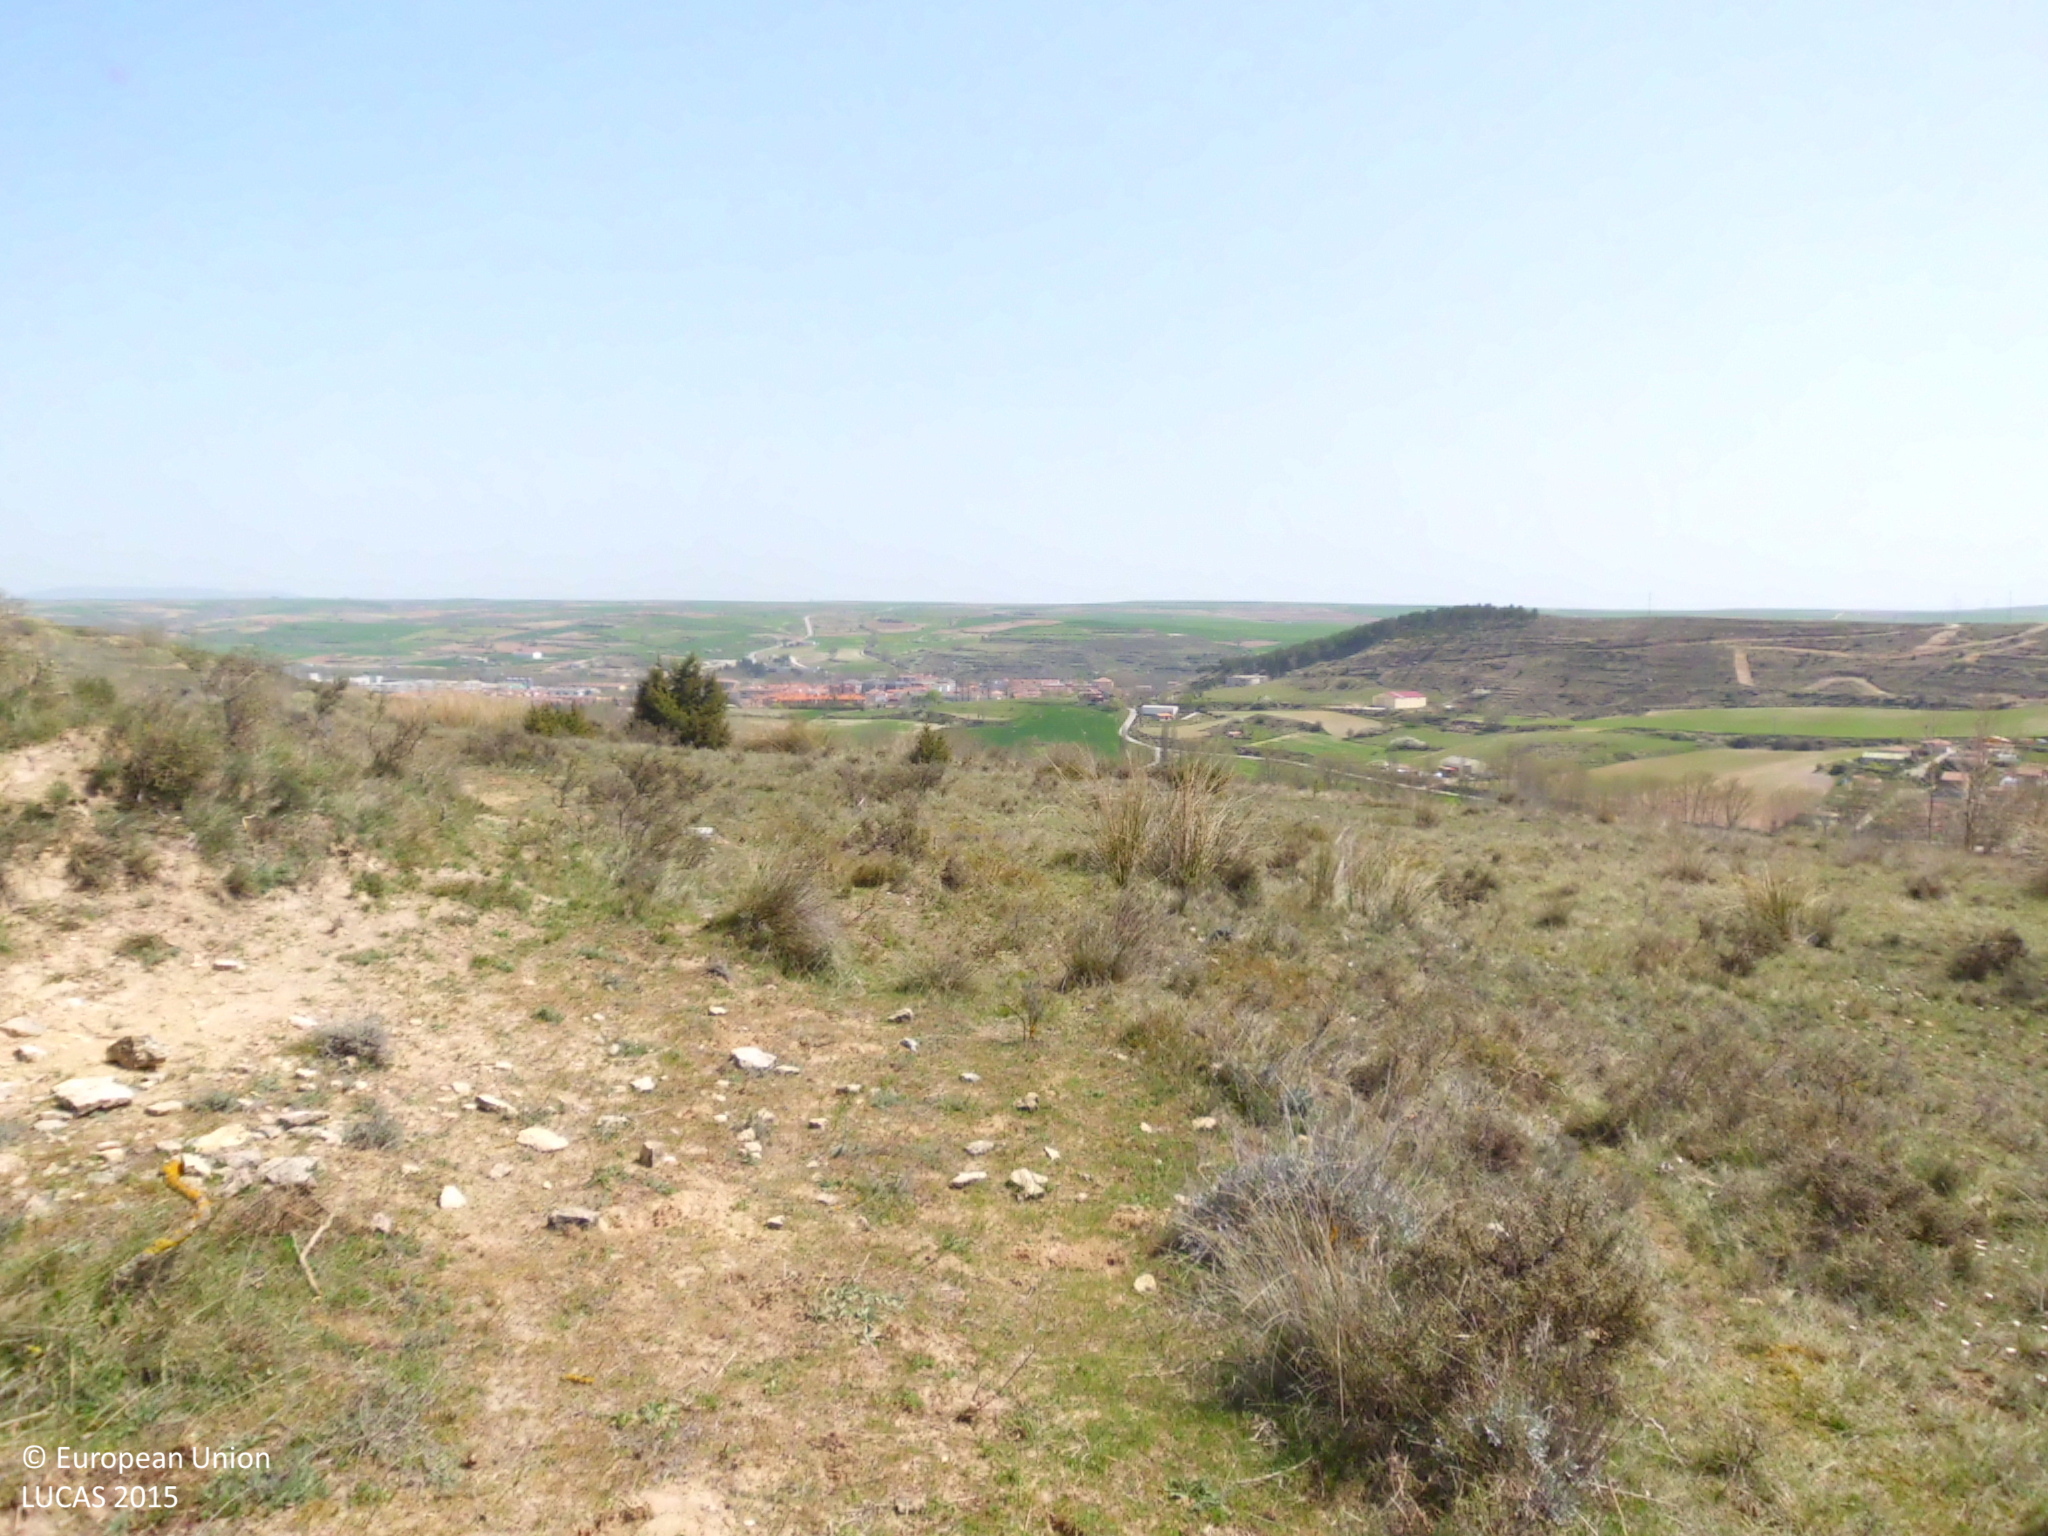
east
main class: Grassland
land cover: Grassland without tree/shrub cover
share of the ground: 50 - 75 %
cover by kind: herbaceous plants 60 %, unconsolidated bare surface 25 %, consolidated bare surface 10 %, shrubs 5 %
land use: Abandoned areas
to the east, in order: Grassland without tree/shrub cover; Barley; Grass margins; Abandoned hedges
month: April
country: ES
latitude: 42.5526
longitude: -3.3445
